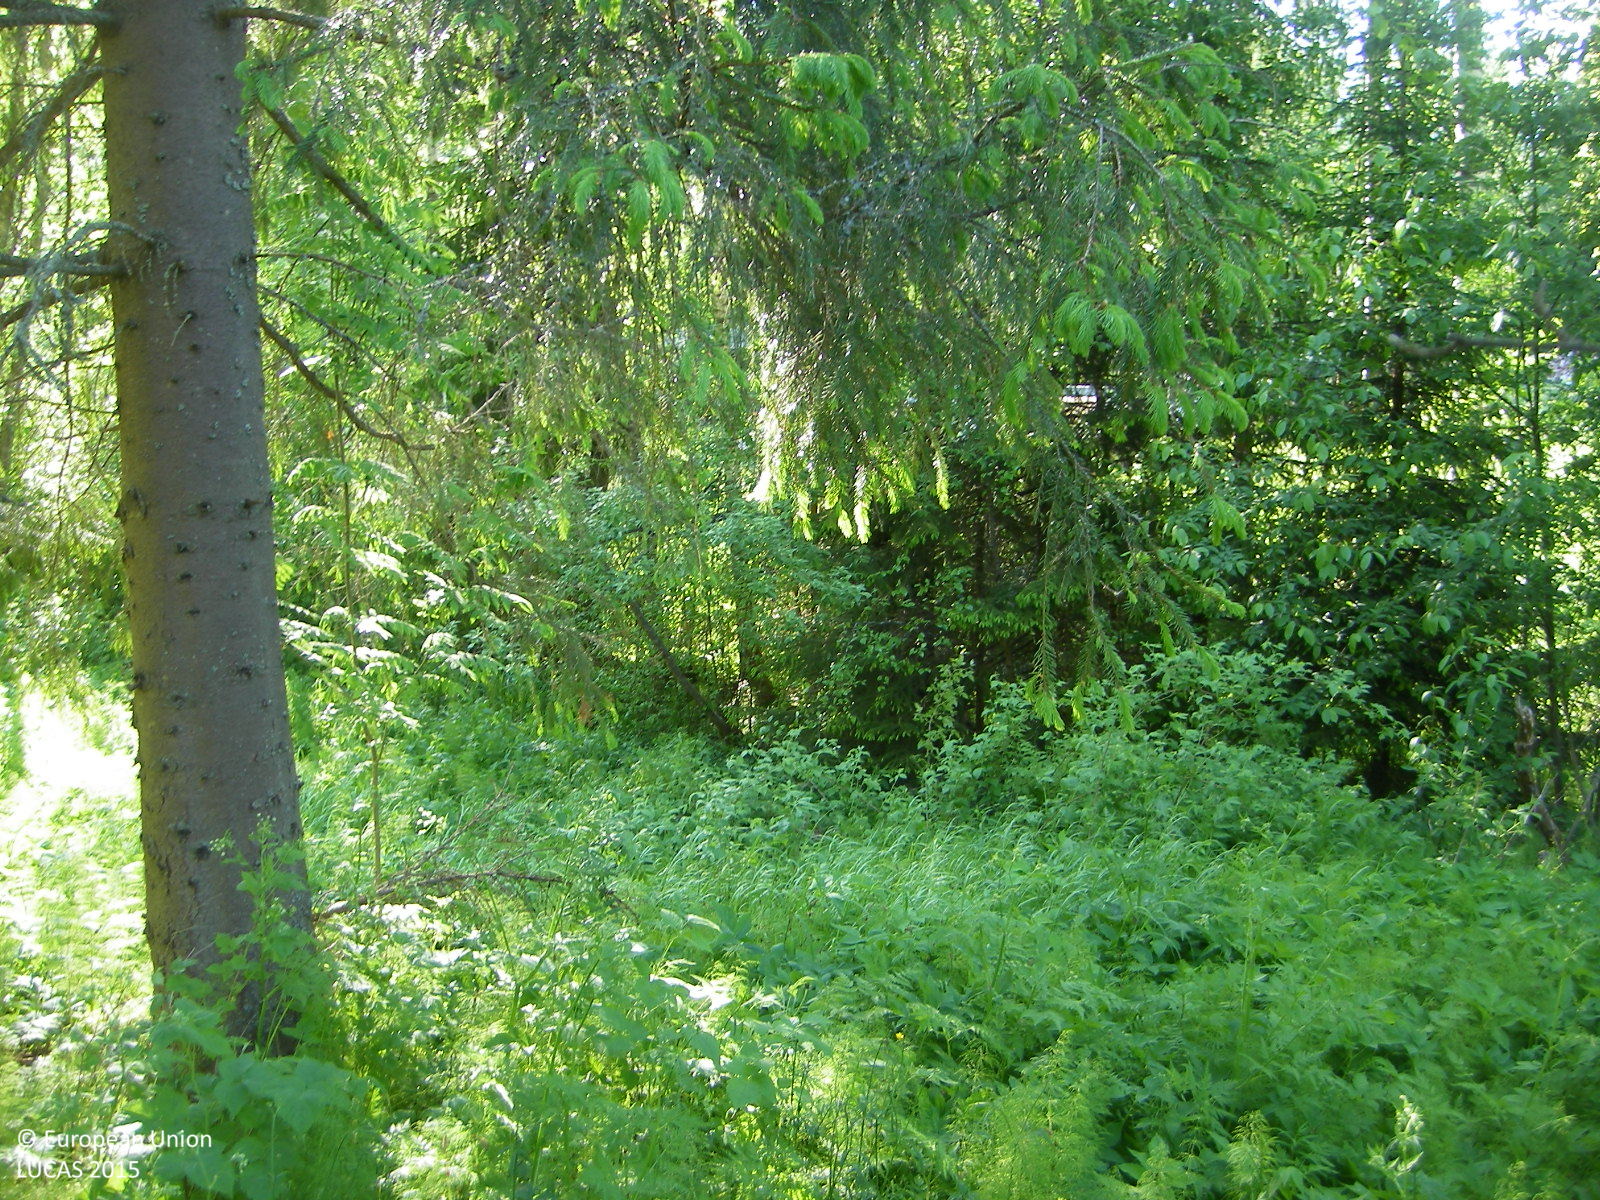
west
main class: Woodland
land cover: Spruce dominated mixed woodland
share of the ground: 50 - 75 %
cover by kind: coniferous forest trees 35 %, broadleaved forest trees 35 %, herbaceous plants 30 %
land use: Forestry
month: June
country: FI
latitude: 60.4666
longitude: 24.9013
